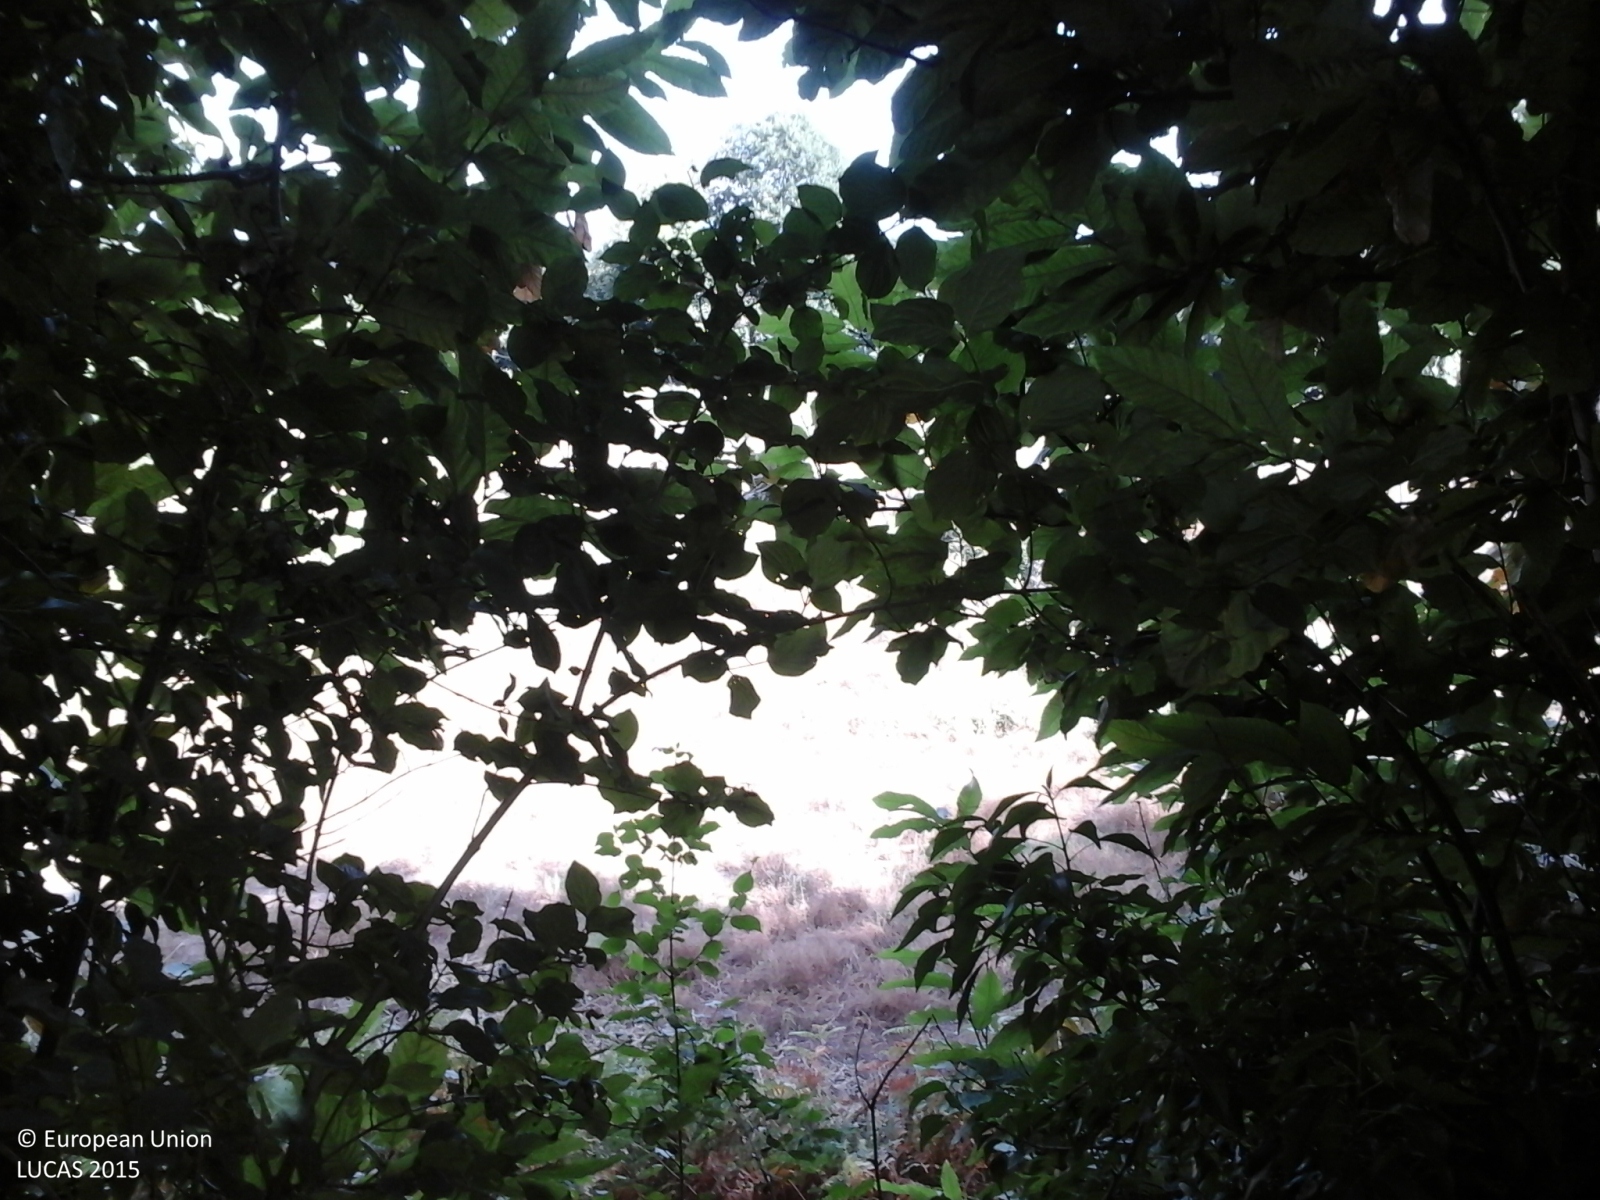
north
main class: Woodland
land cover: Broadleaved woodland
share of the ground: 50 - 75 %
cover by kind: broadleaved forest trees 60 %, shrubs 20 %, herbaceous plants 20 %
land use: Semi-natural and natural areas not in use
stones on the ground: < 10 %
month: August
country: IT
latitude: 42.6223
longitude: 11.6648
